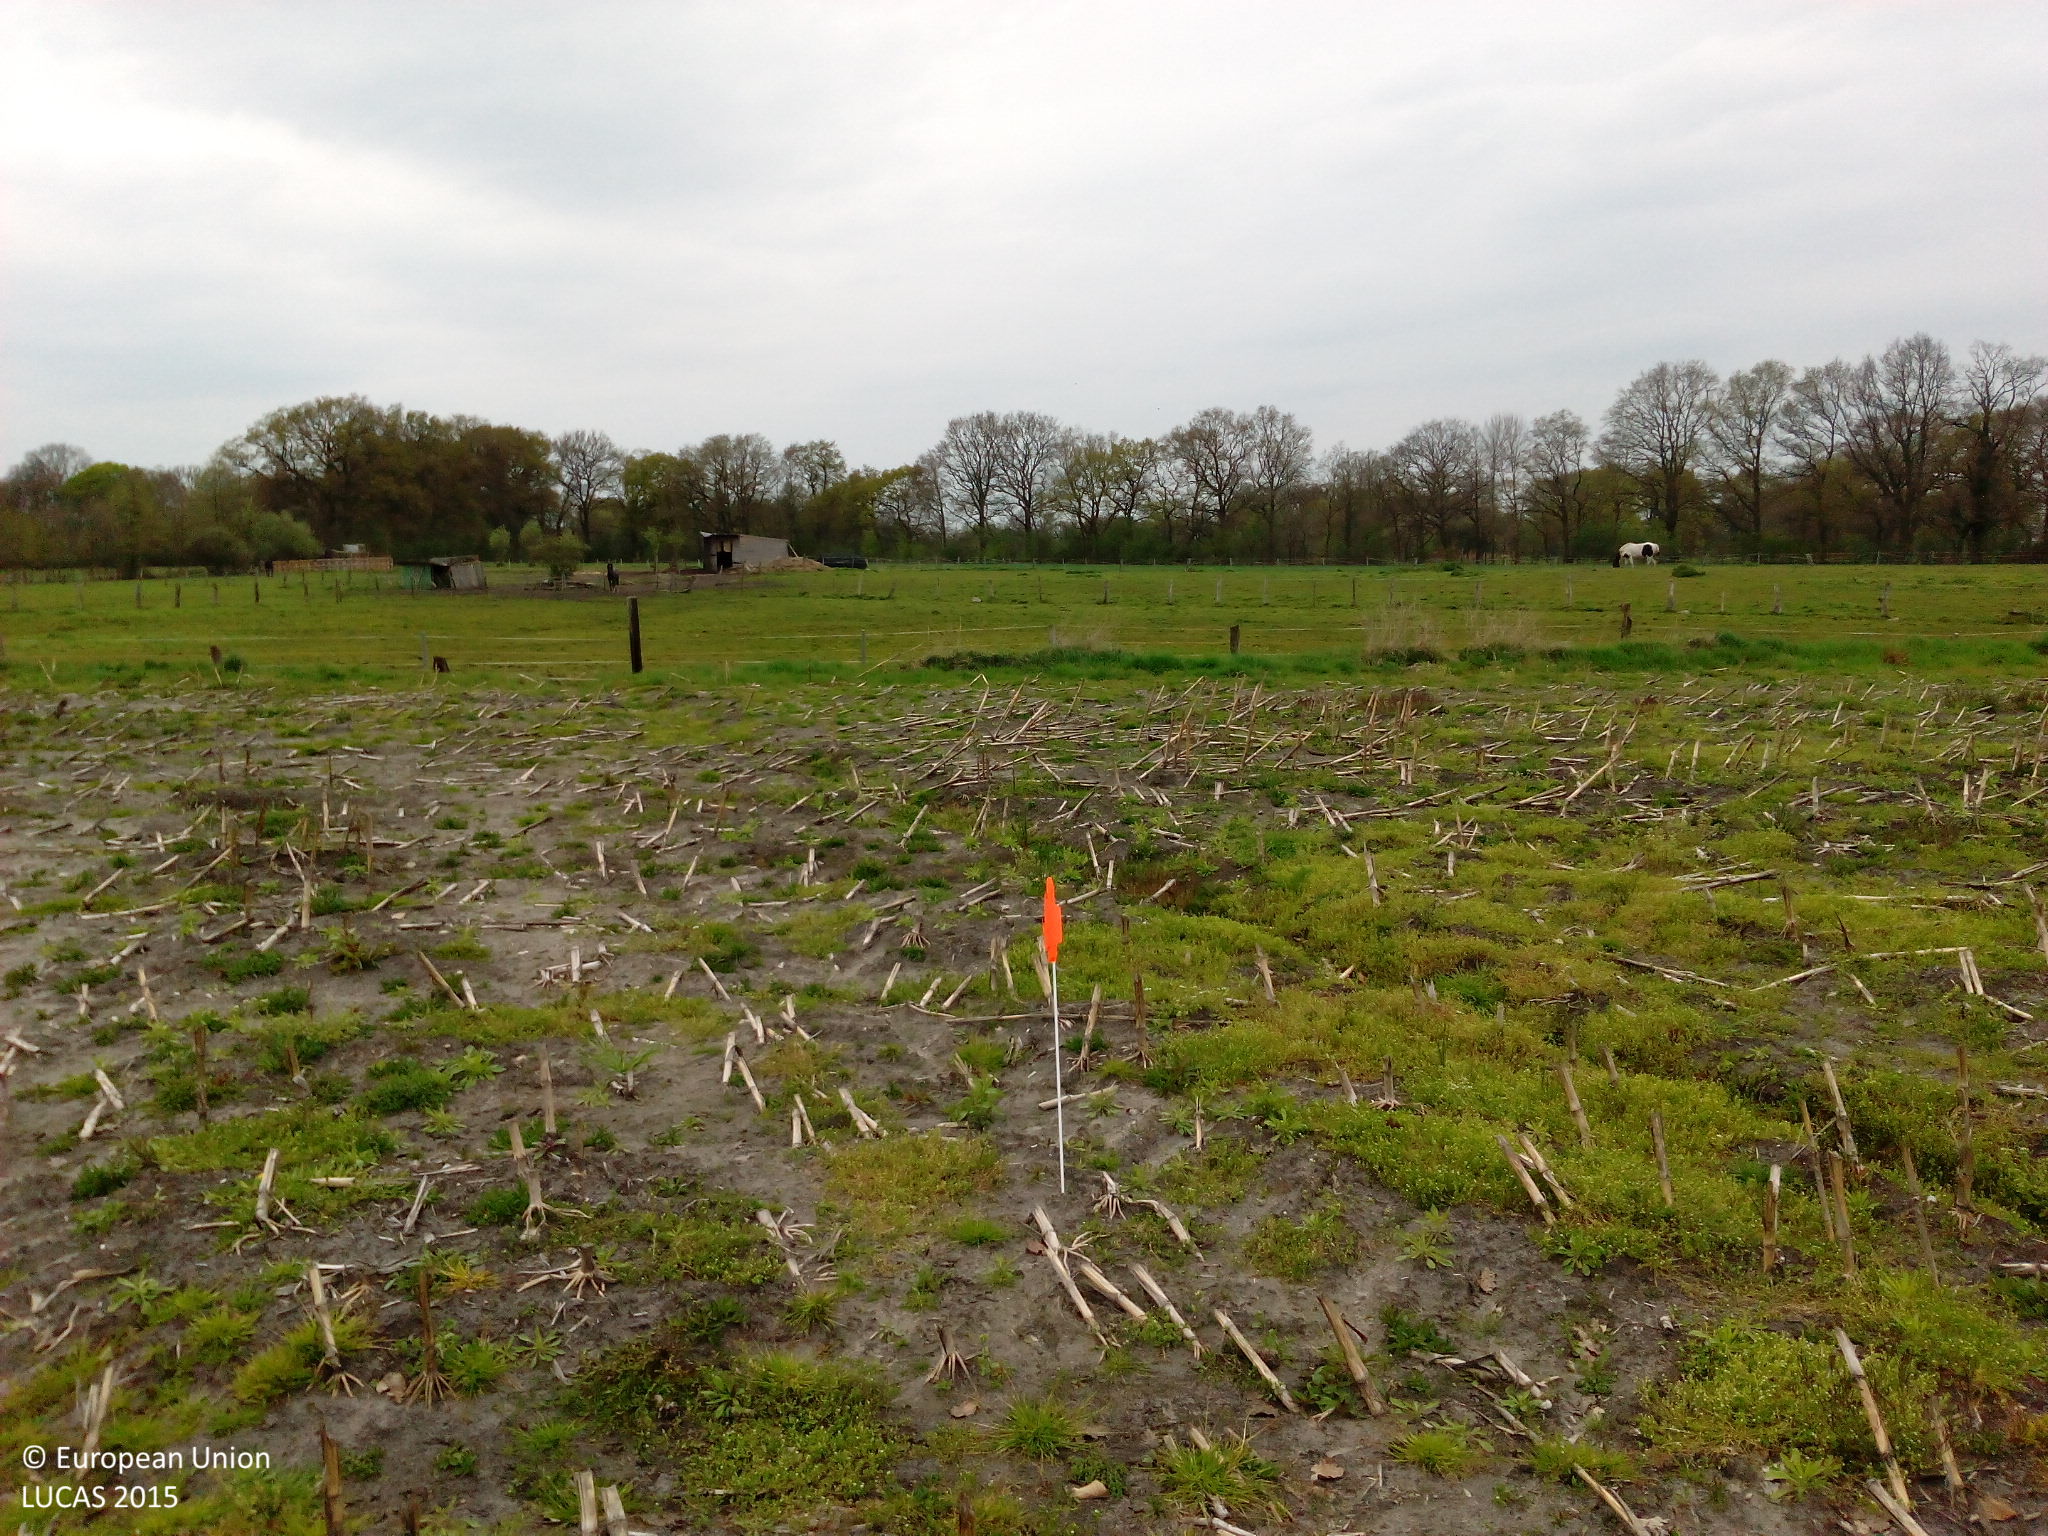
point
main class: Grassland
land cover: Spontaneously vegetated surfaces
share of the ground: 50 - 75 %
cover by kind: herbaceous plants 50 %, consolidated bare surface 30 %, lichens and mosses 20 %
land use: Fallow land
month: May
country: DE
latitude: 53.2498
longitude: 8.5768
